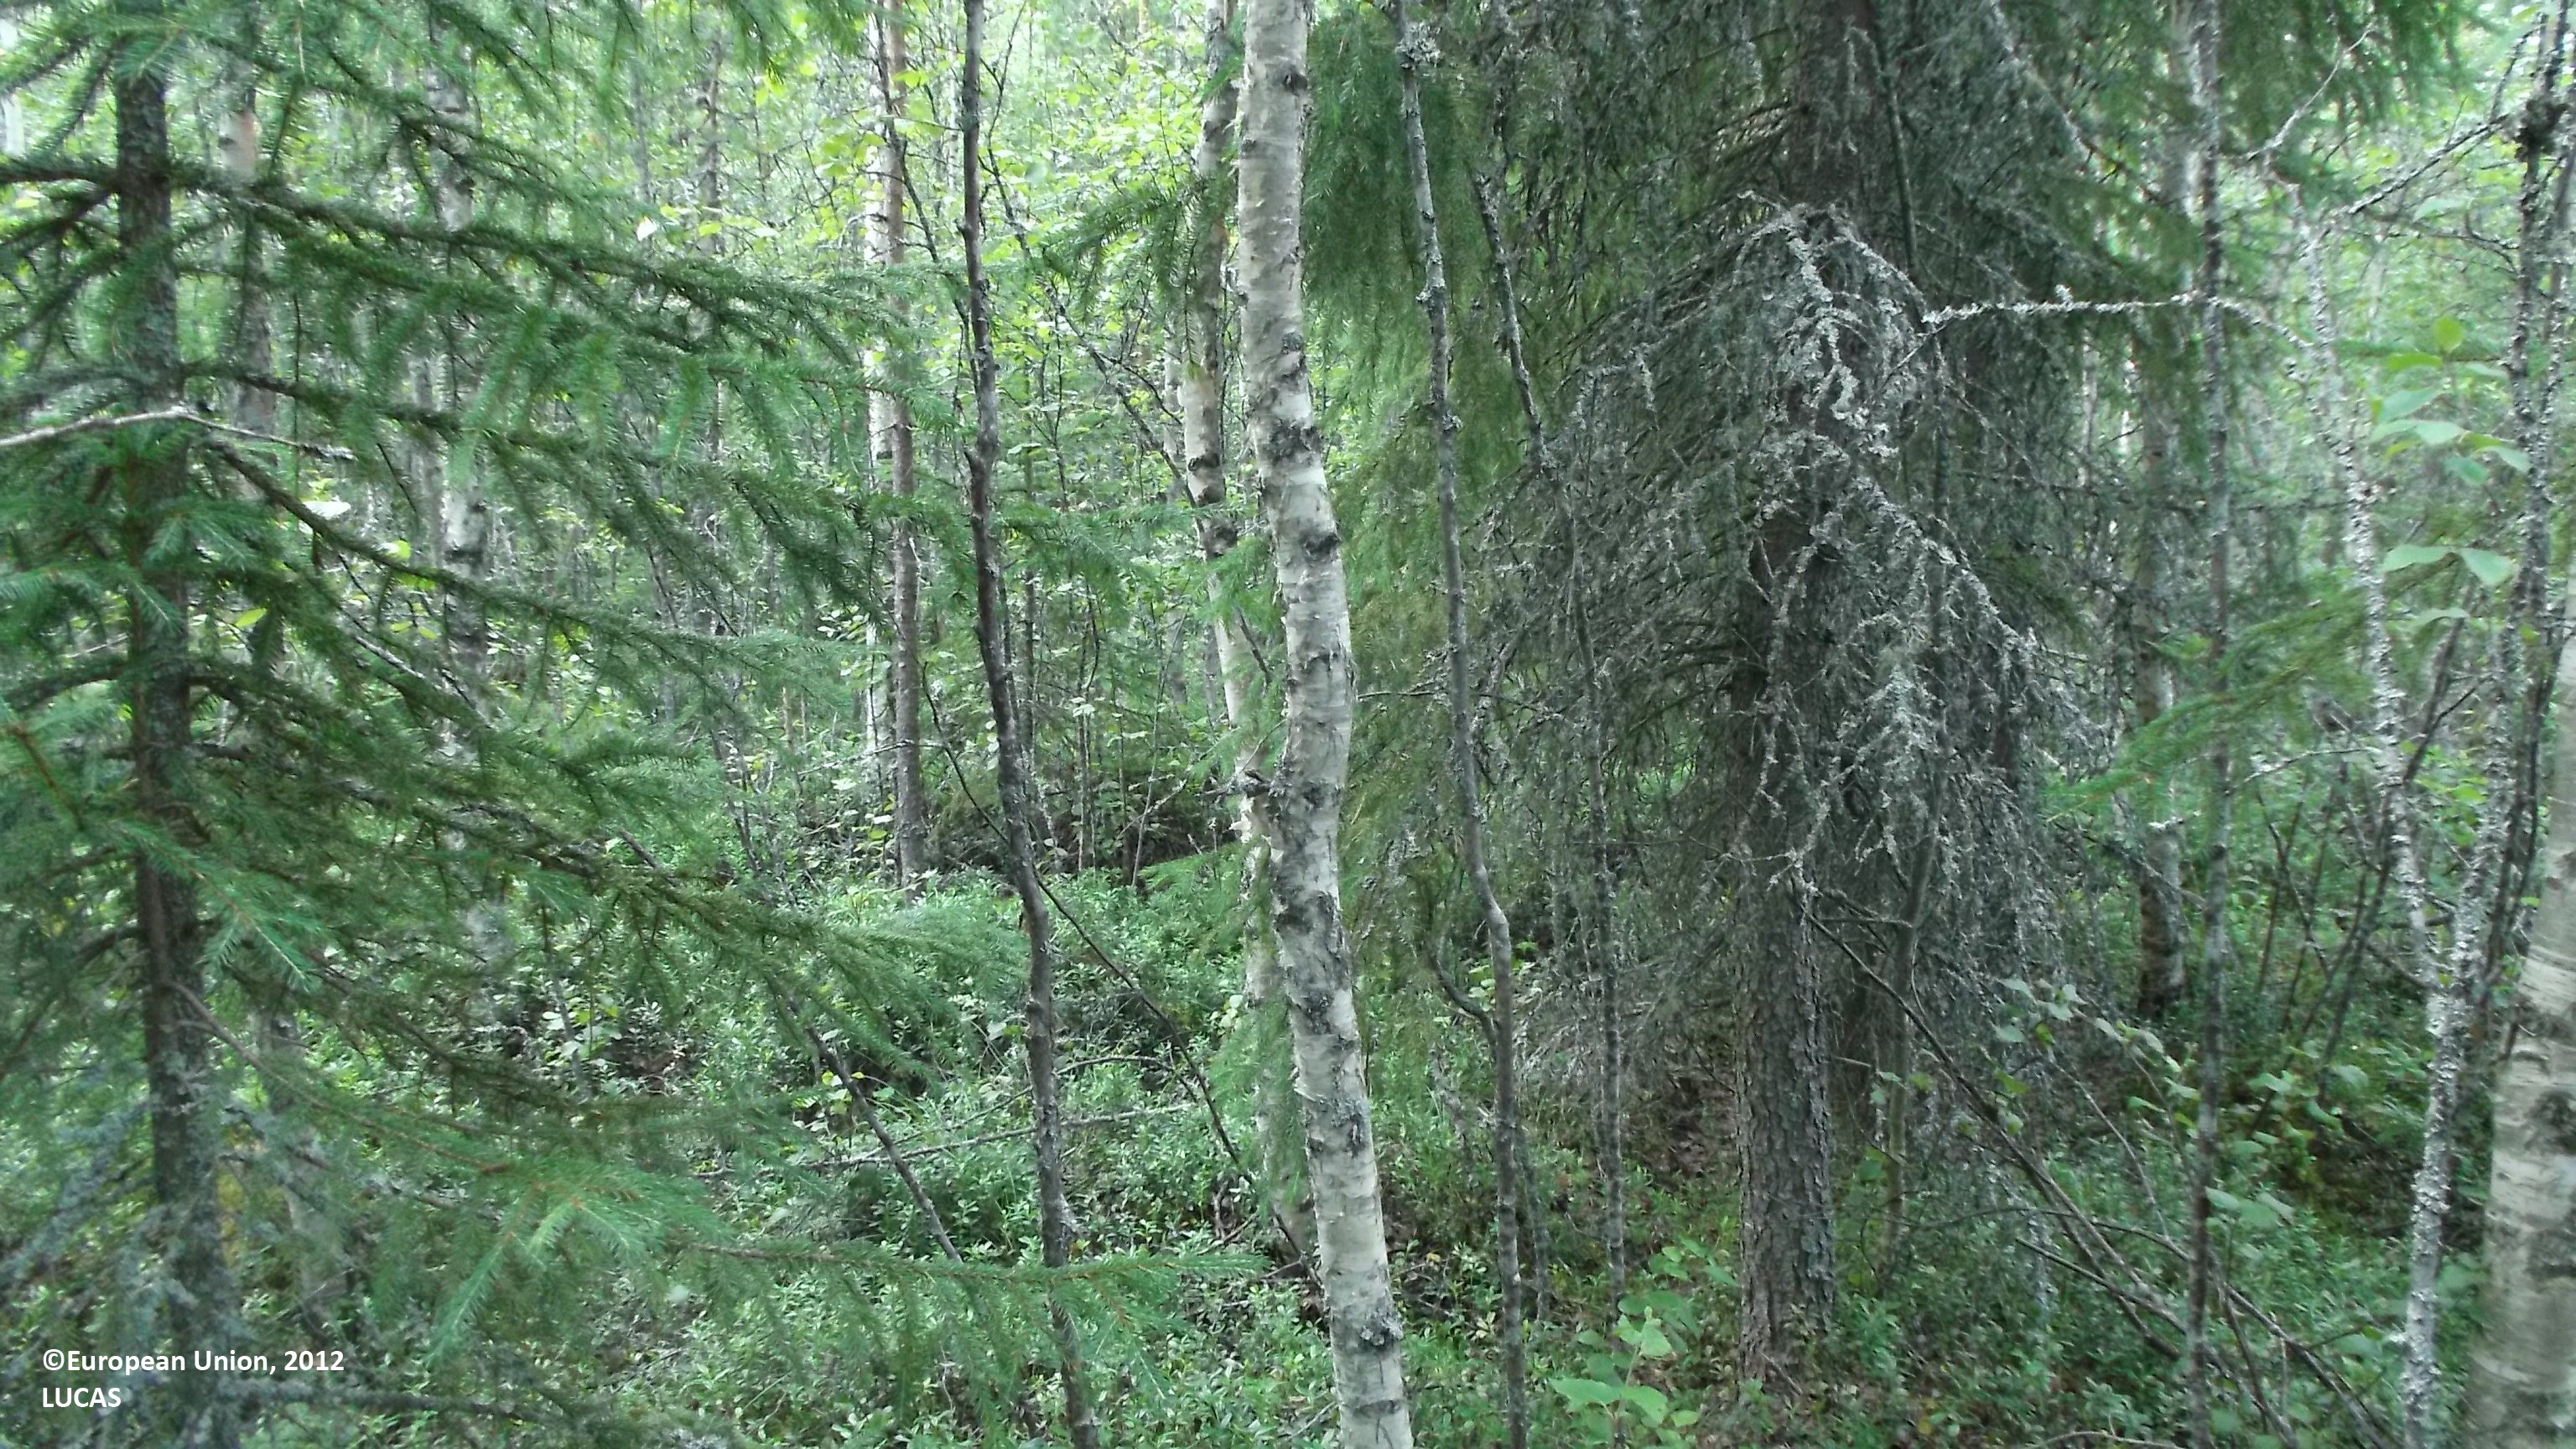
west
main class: Woodland
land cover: Spruce dominated mixed woodland
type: boreal forest
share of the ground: > 75 %
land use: Forestry
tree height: > 5 m
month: July
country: FI
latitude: 63.5915
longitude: 22.9296
